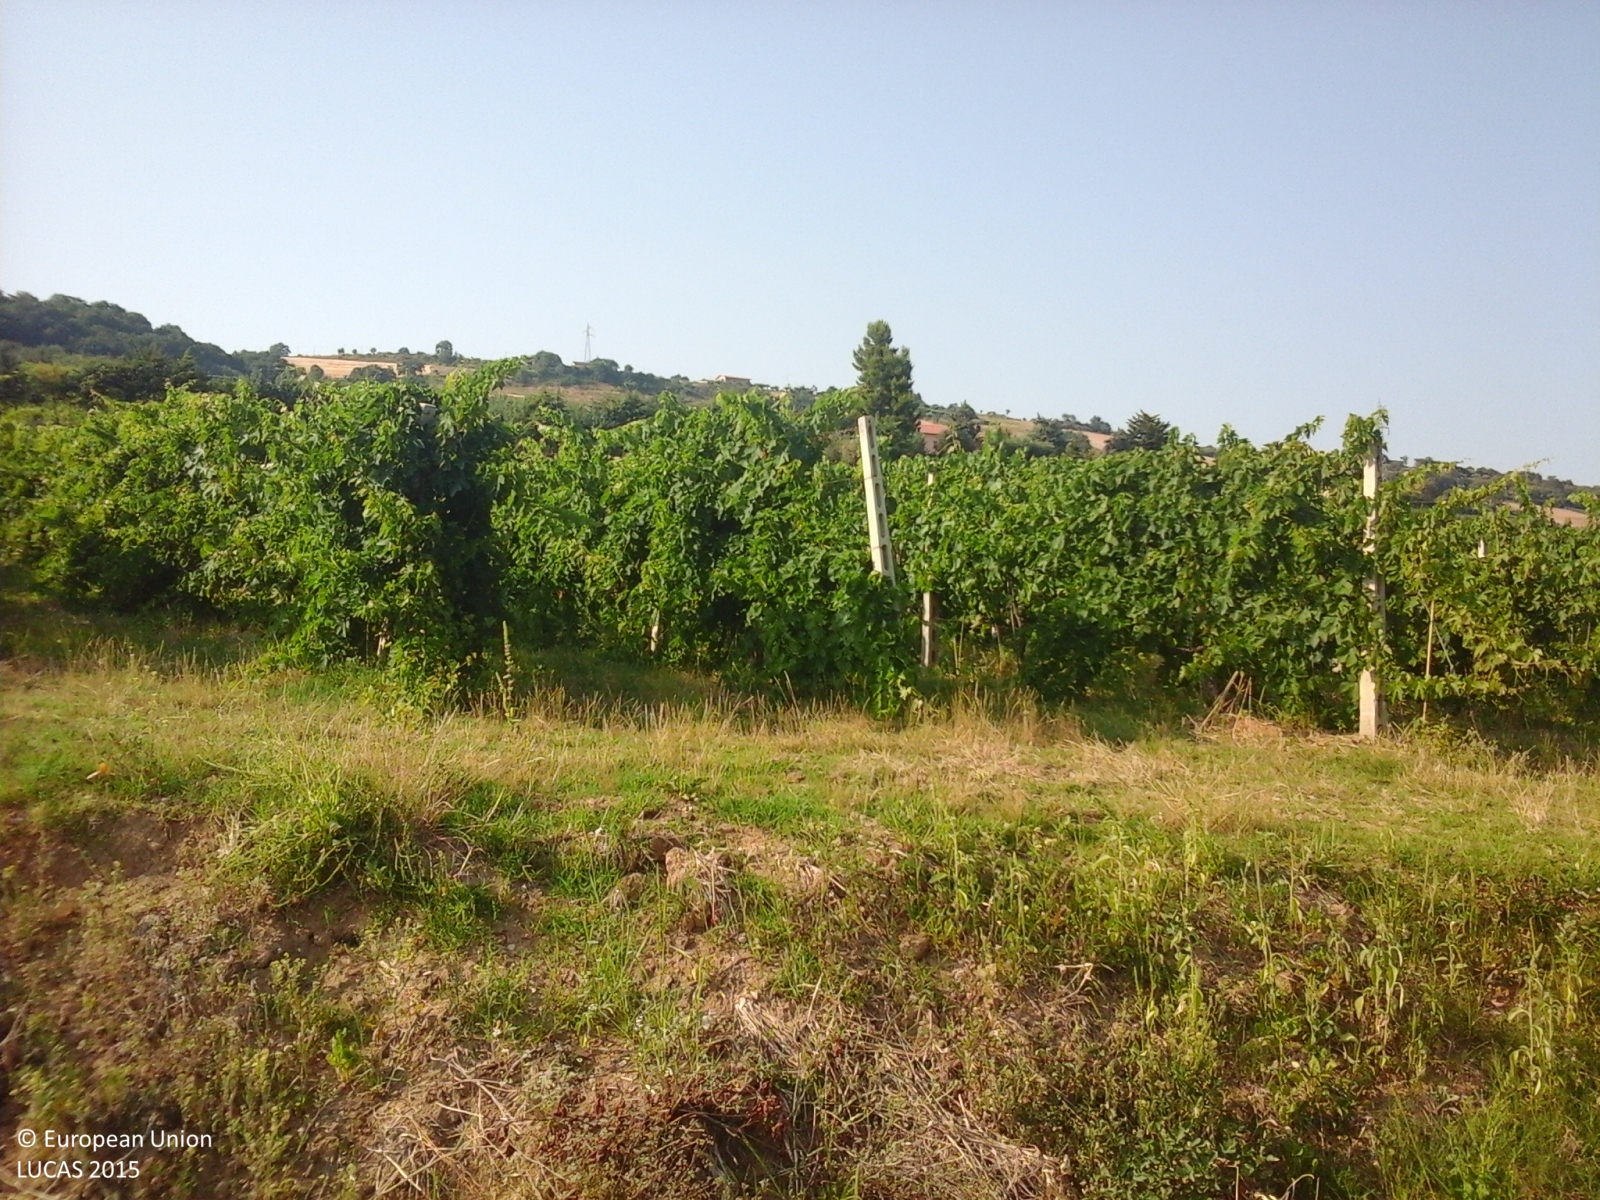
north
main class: Cropland
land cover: Vineyards
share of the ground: 50 - 75 %
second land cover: Grassland without tree/shrub cover
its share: > 75 %
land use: Agriculture (excluding fallow land and kitchen gardens)
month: July
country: IT
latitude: 43.0894
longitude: 13.7860
